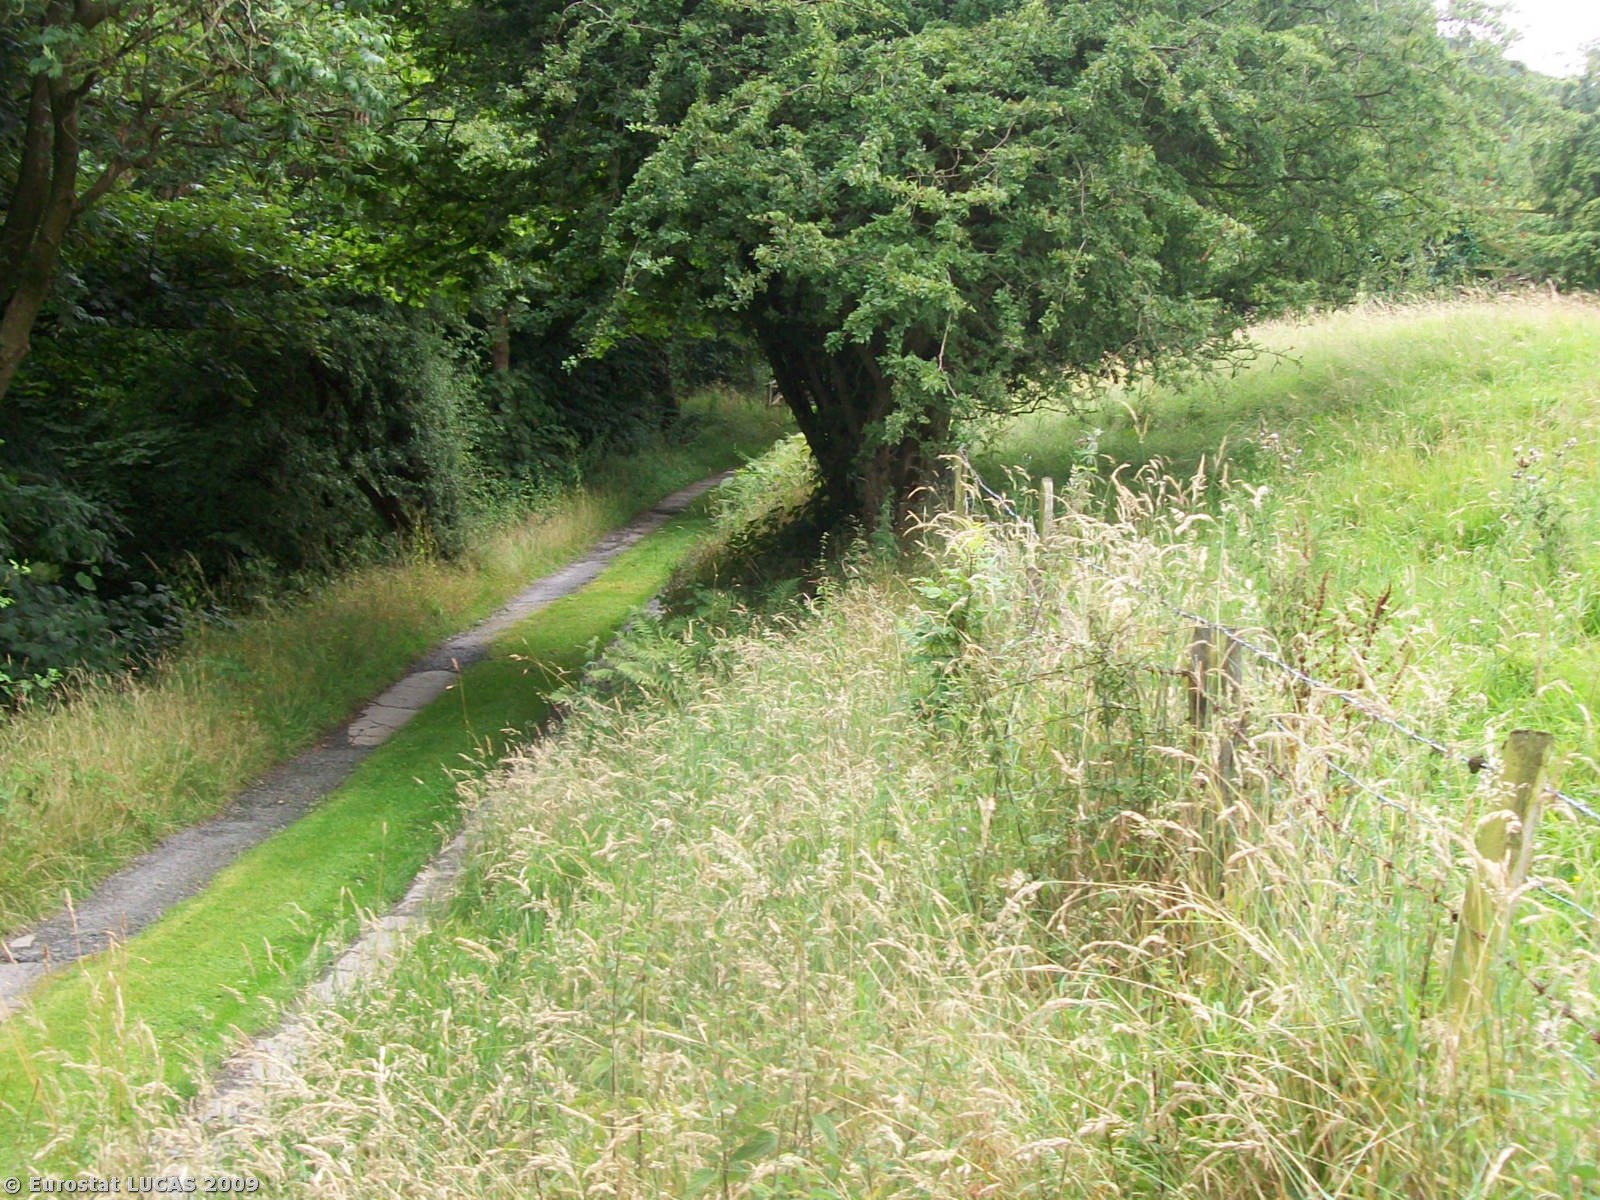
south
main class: Grassland
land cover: Grassland without tree/shrub cover
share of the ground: > 75 %
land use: Agriculture (excluding fallow land and kitchen gardens)
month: August
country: GB
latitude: 52.8034
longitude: -3.3572
